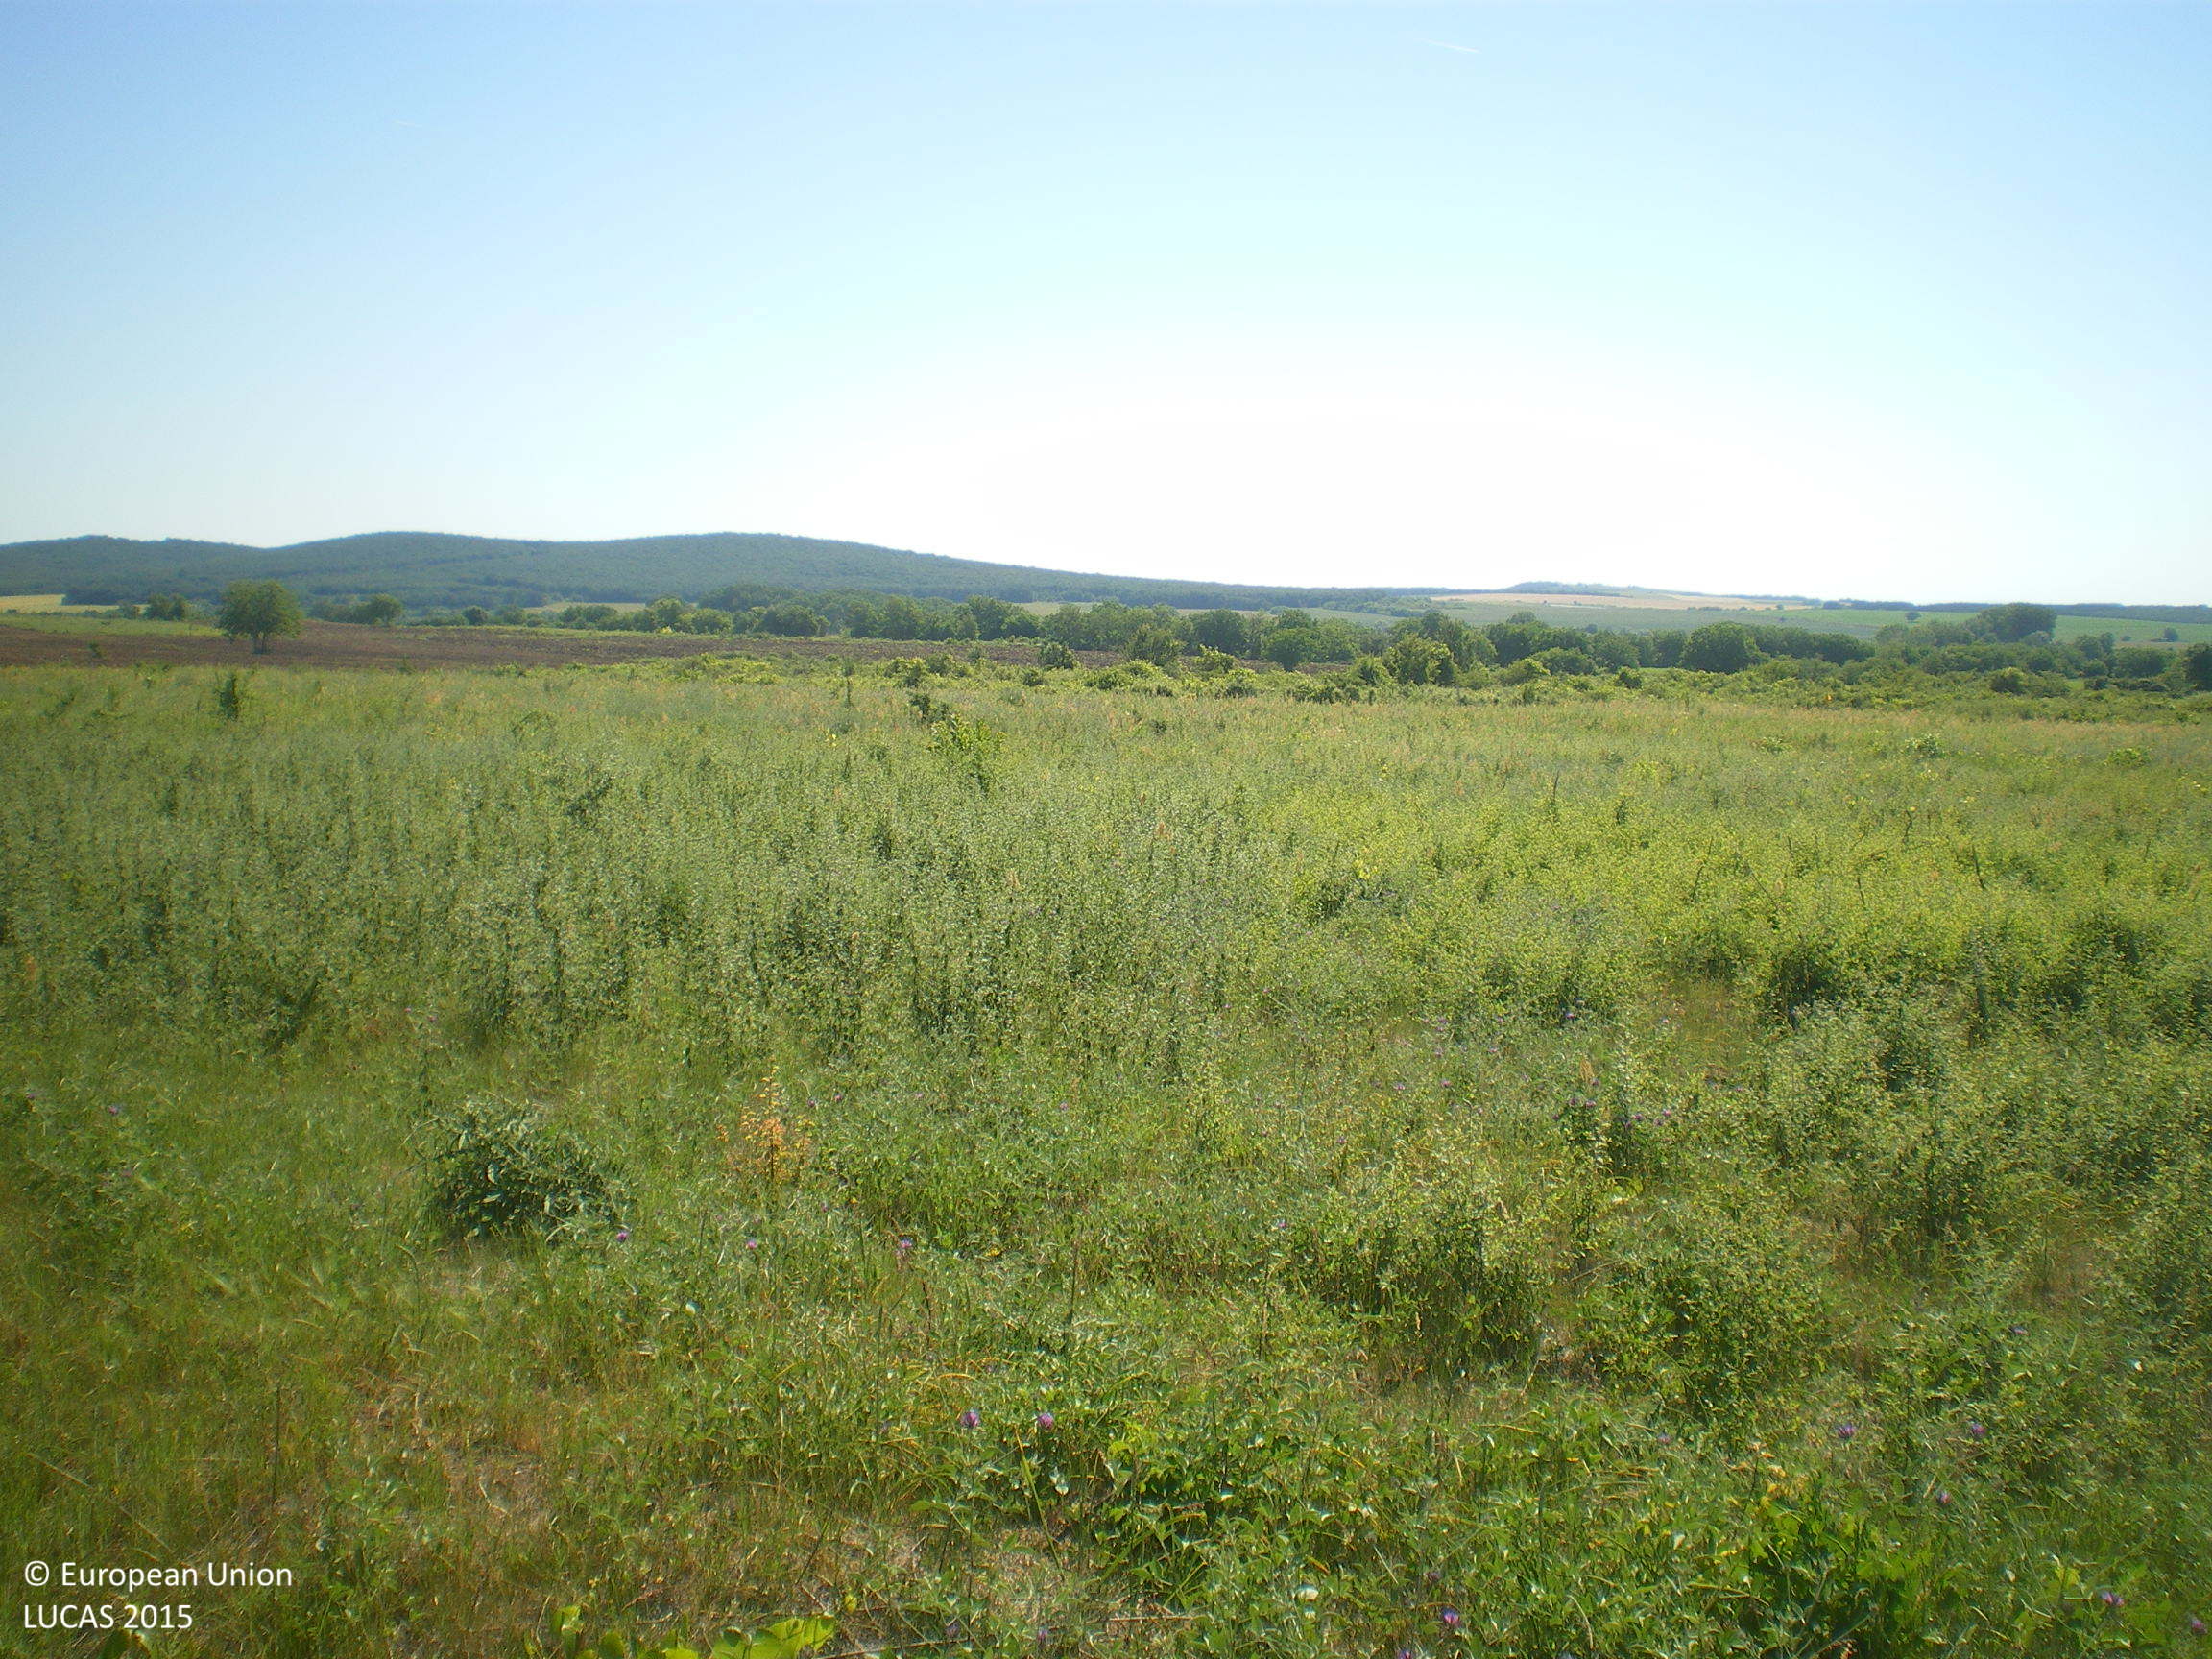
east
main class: Cropland
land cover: Vineyards
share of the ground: 10 - 25 %
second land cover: Shrubland without tree cover
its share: 50 - 75 %
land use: Abandoned areas
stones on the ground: < 10 %
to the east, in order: Vineyards; Shrubland without tree cover; Shrubland with sparse tree cover; Other bare soil
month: June
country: BG
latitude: 42.3029
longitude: 25.4605
